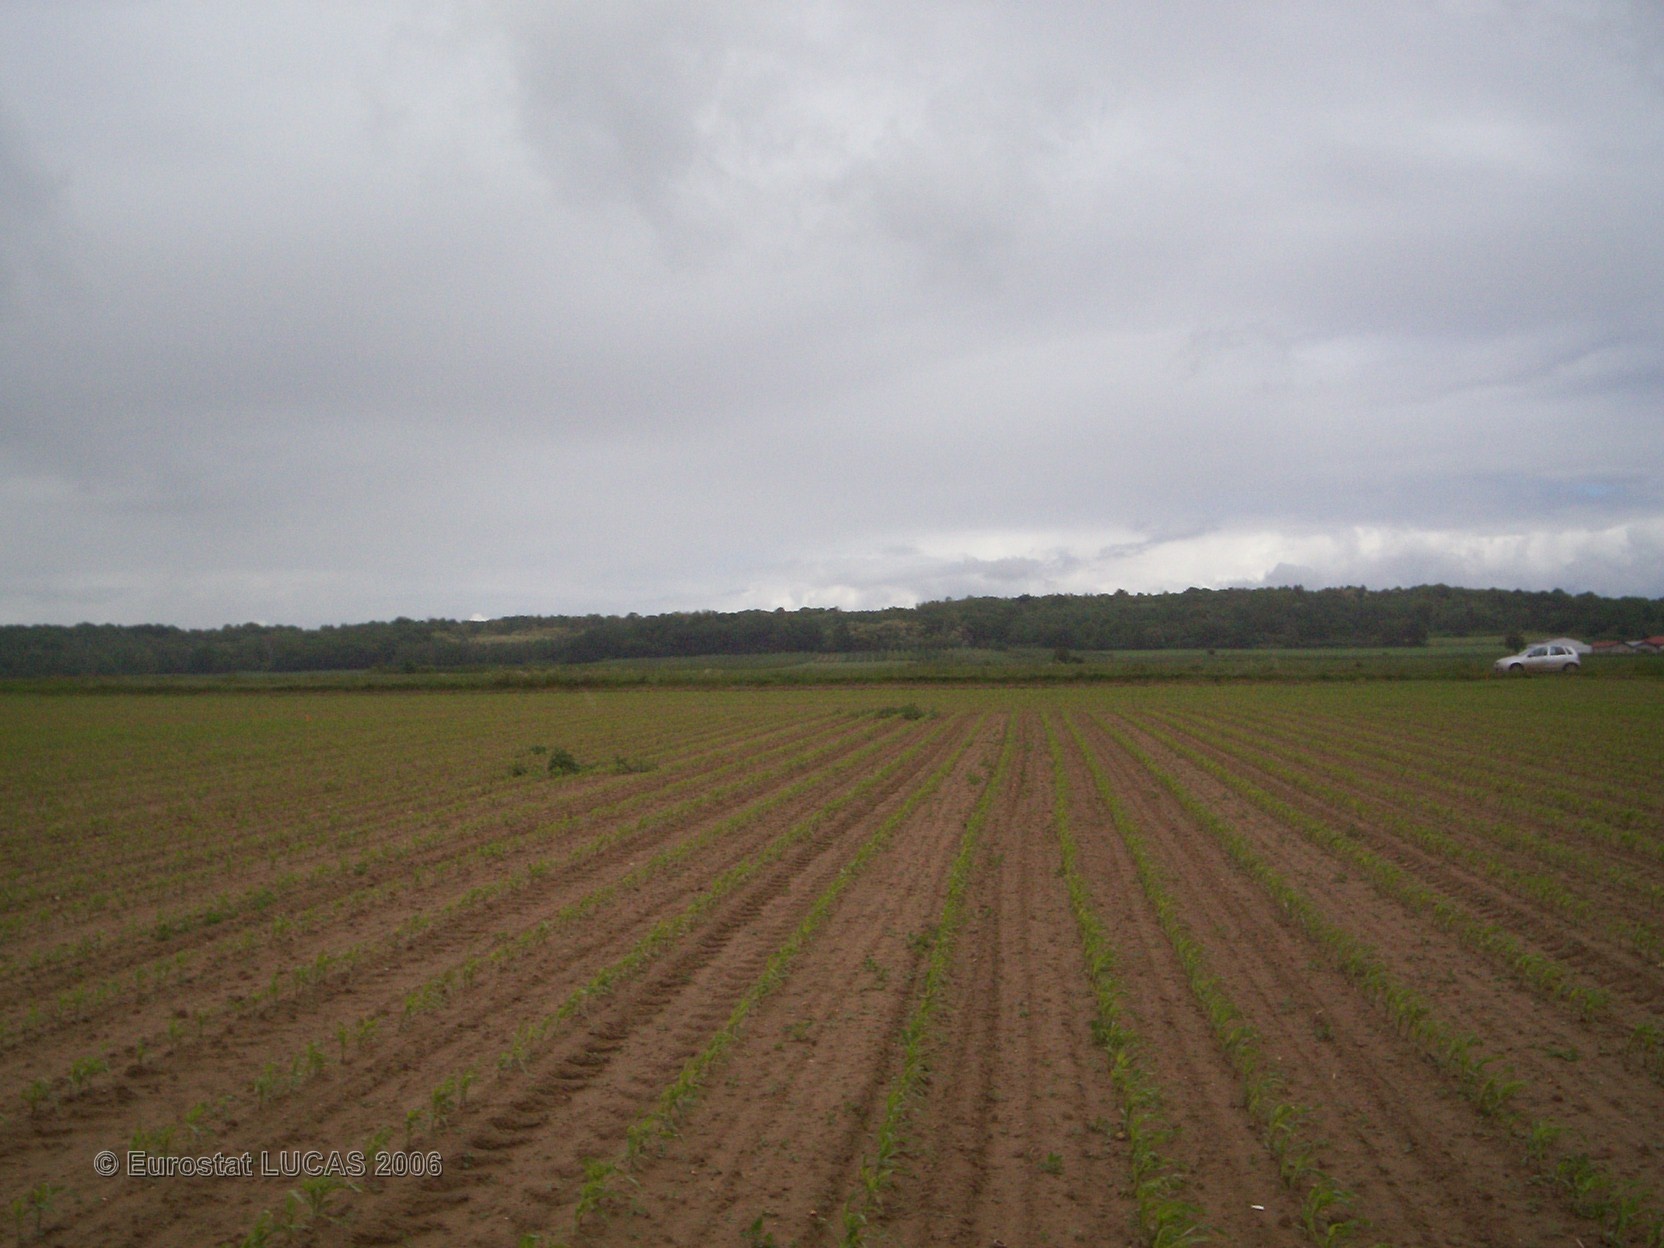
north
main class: Cropland
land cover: Maize
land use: Agriculture (excluding fallow land and kitchen gardens)
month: May
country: FR
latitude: 49.2330
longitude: 2.7798
